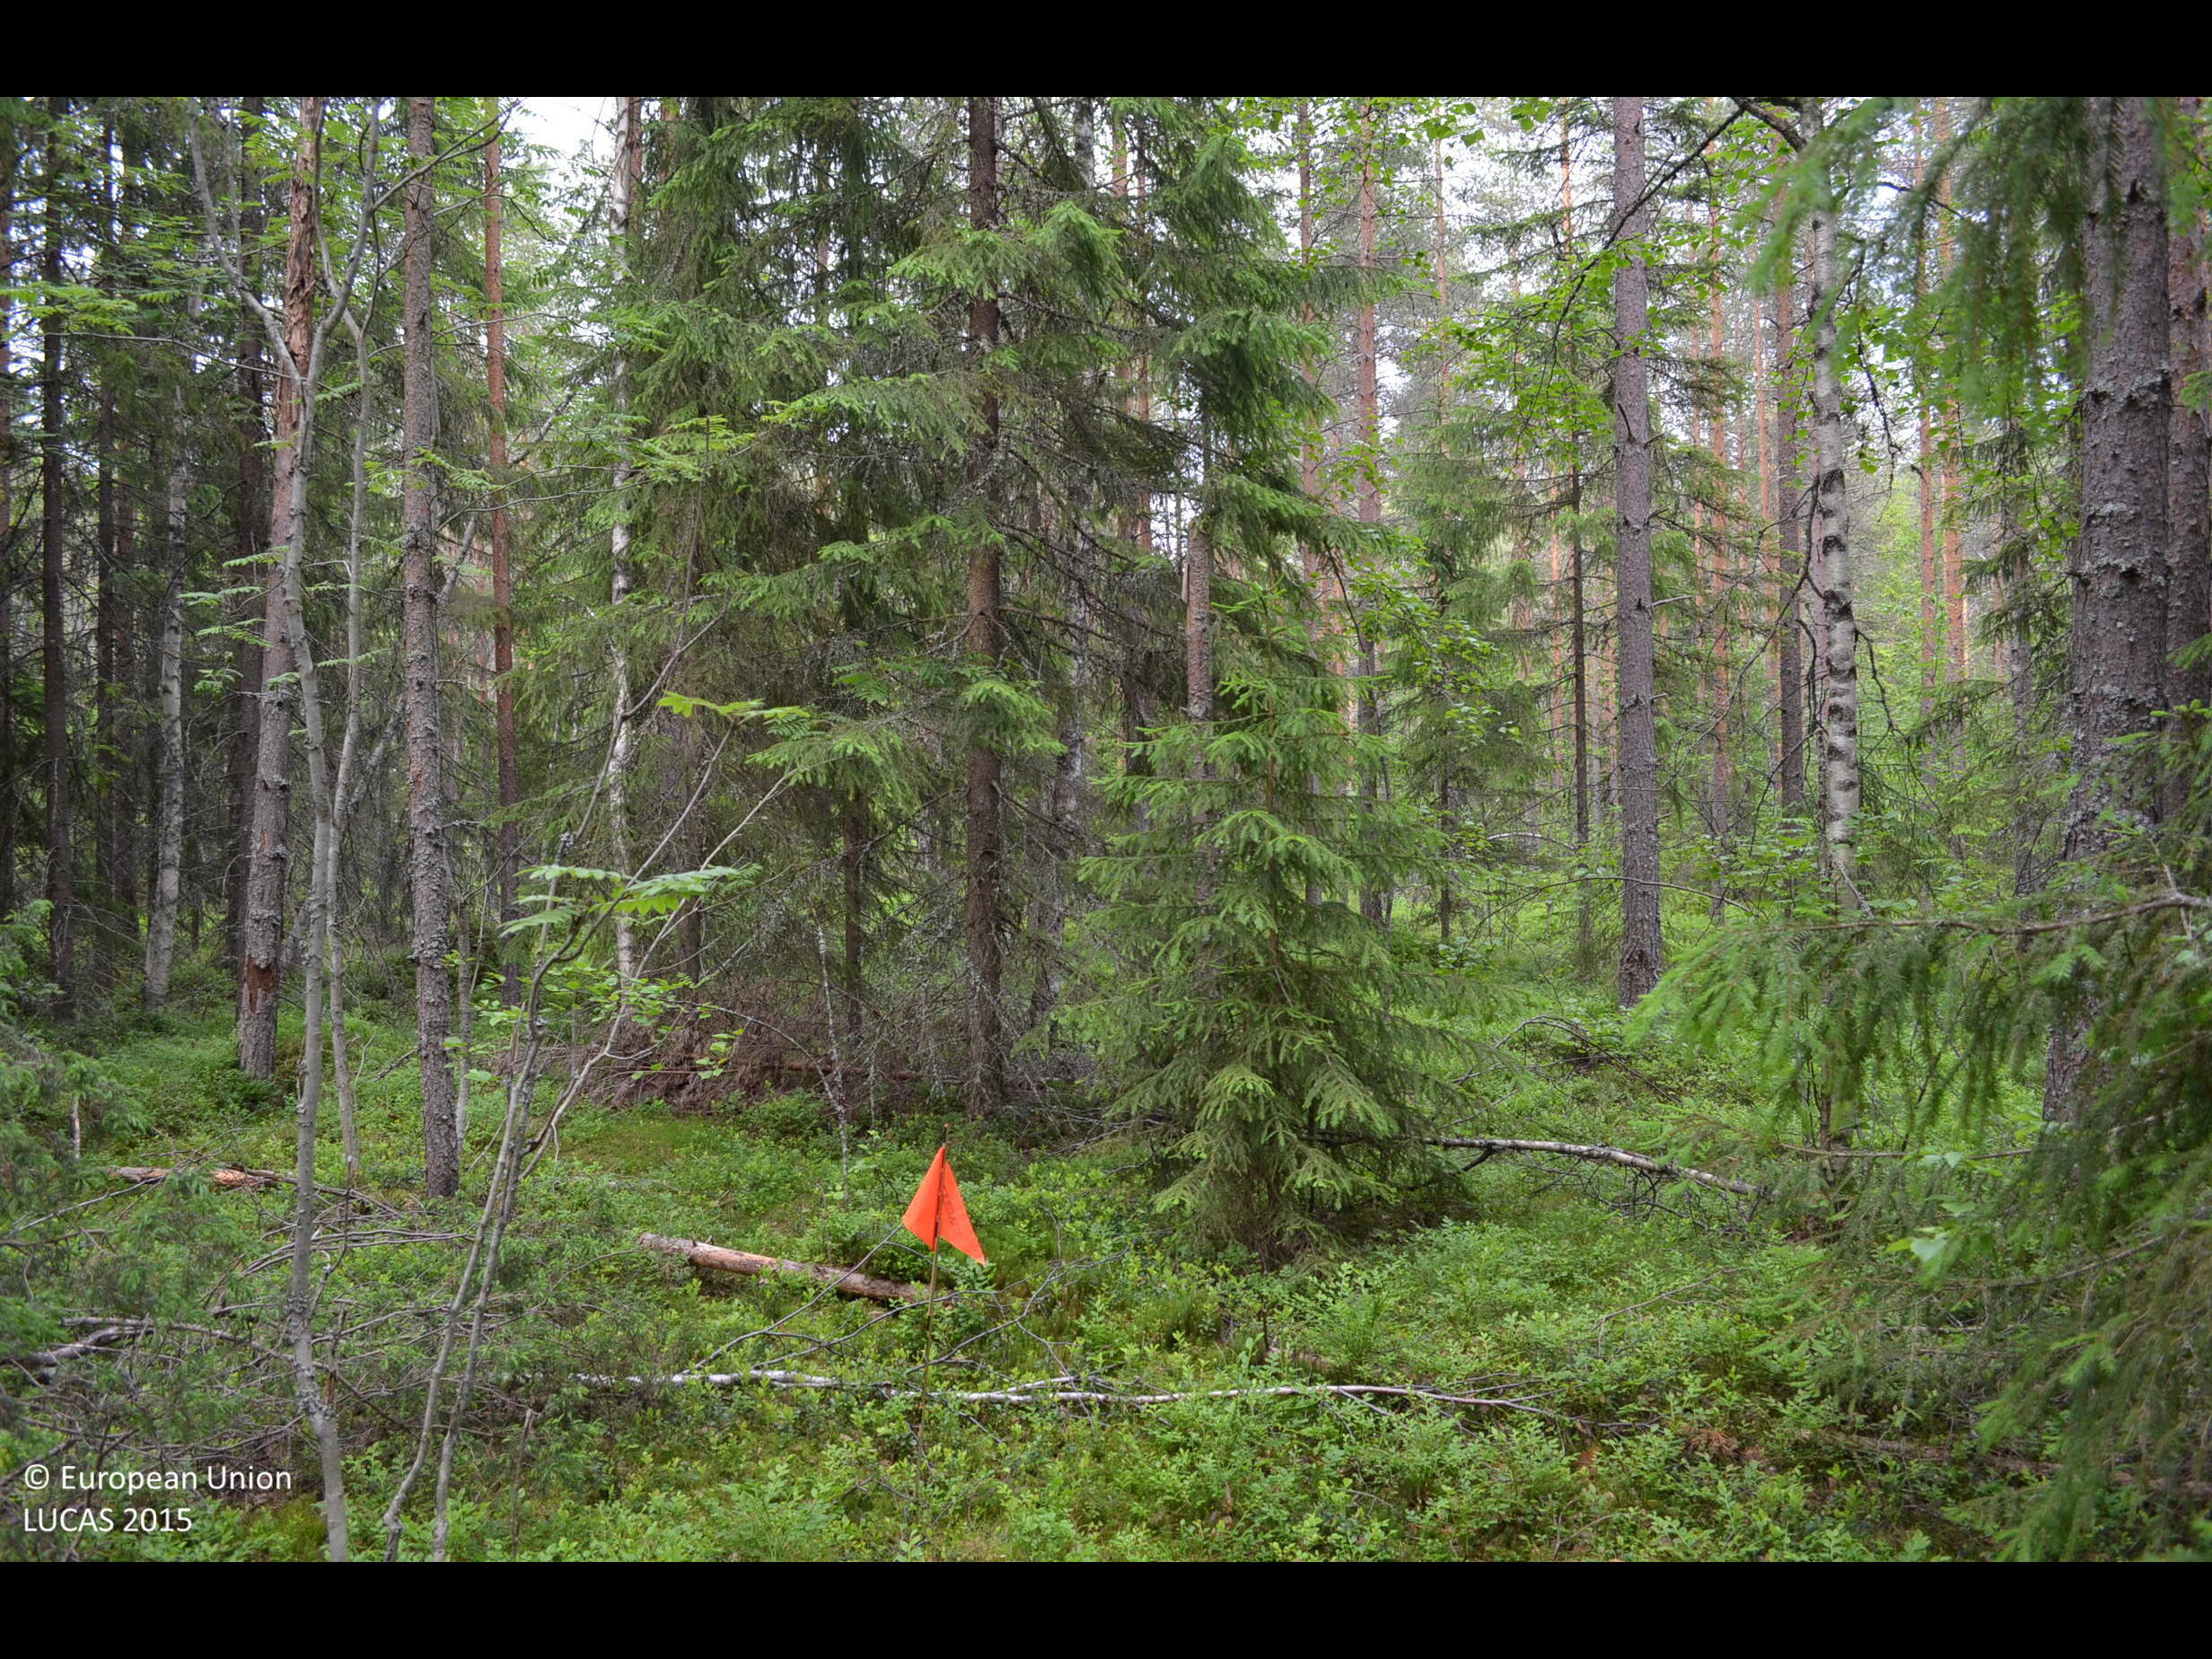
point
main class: Woodland
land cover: Other coniferous woodland
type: boreal forest
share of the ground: > 75 %
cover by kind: coniferous forest trees 60 %, broadleaved forest trees 20 %, shrubs 20 %
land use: Forestry
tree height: > 5 m
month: June
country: FI
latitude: 62.0924
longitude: 23.5000
